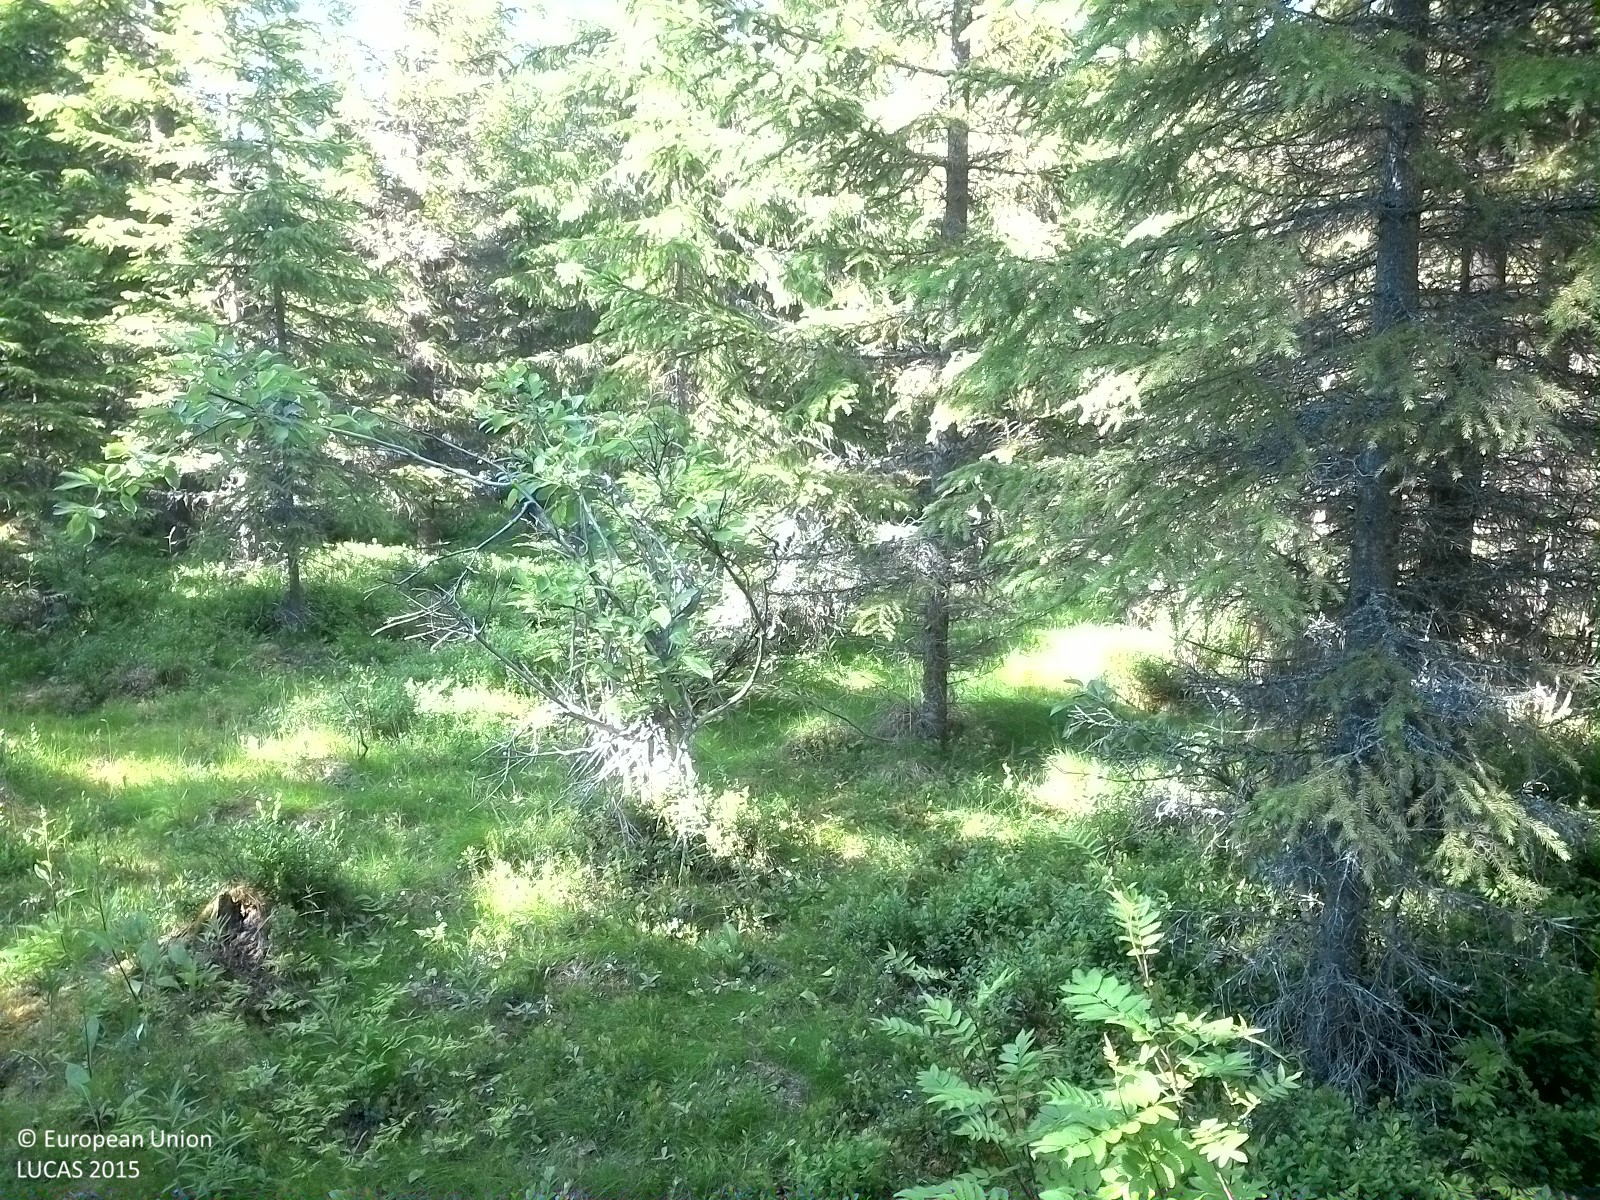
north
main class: Woodland
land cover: Spruce dominated coniferous woodland
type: boreal forest
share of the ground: 50 - 75 %
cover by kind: coniferous forest trees 75 %, shrubs 25 %
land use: Forestry
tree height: > 5 m
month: July
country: SE
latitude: 63.5934
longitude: 15.0746
